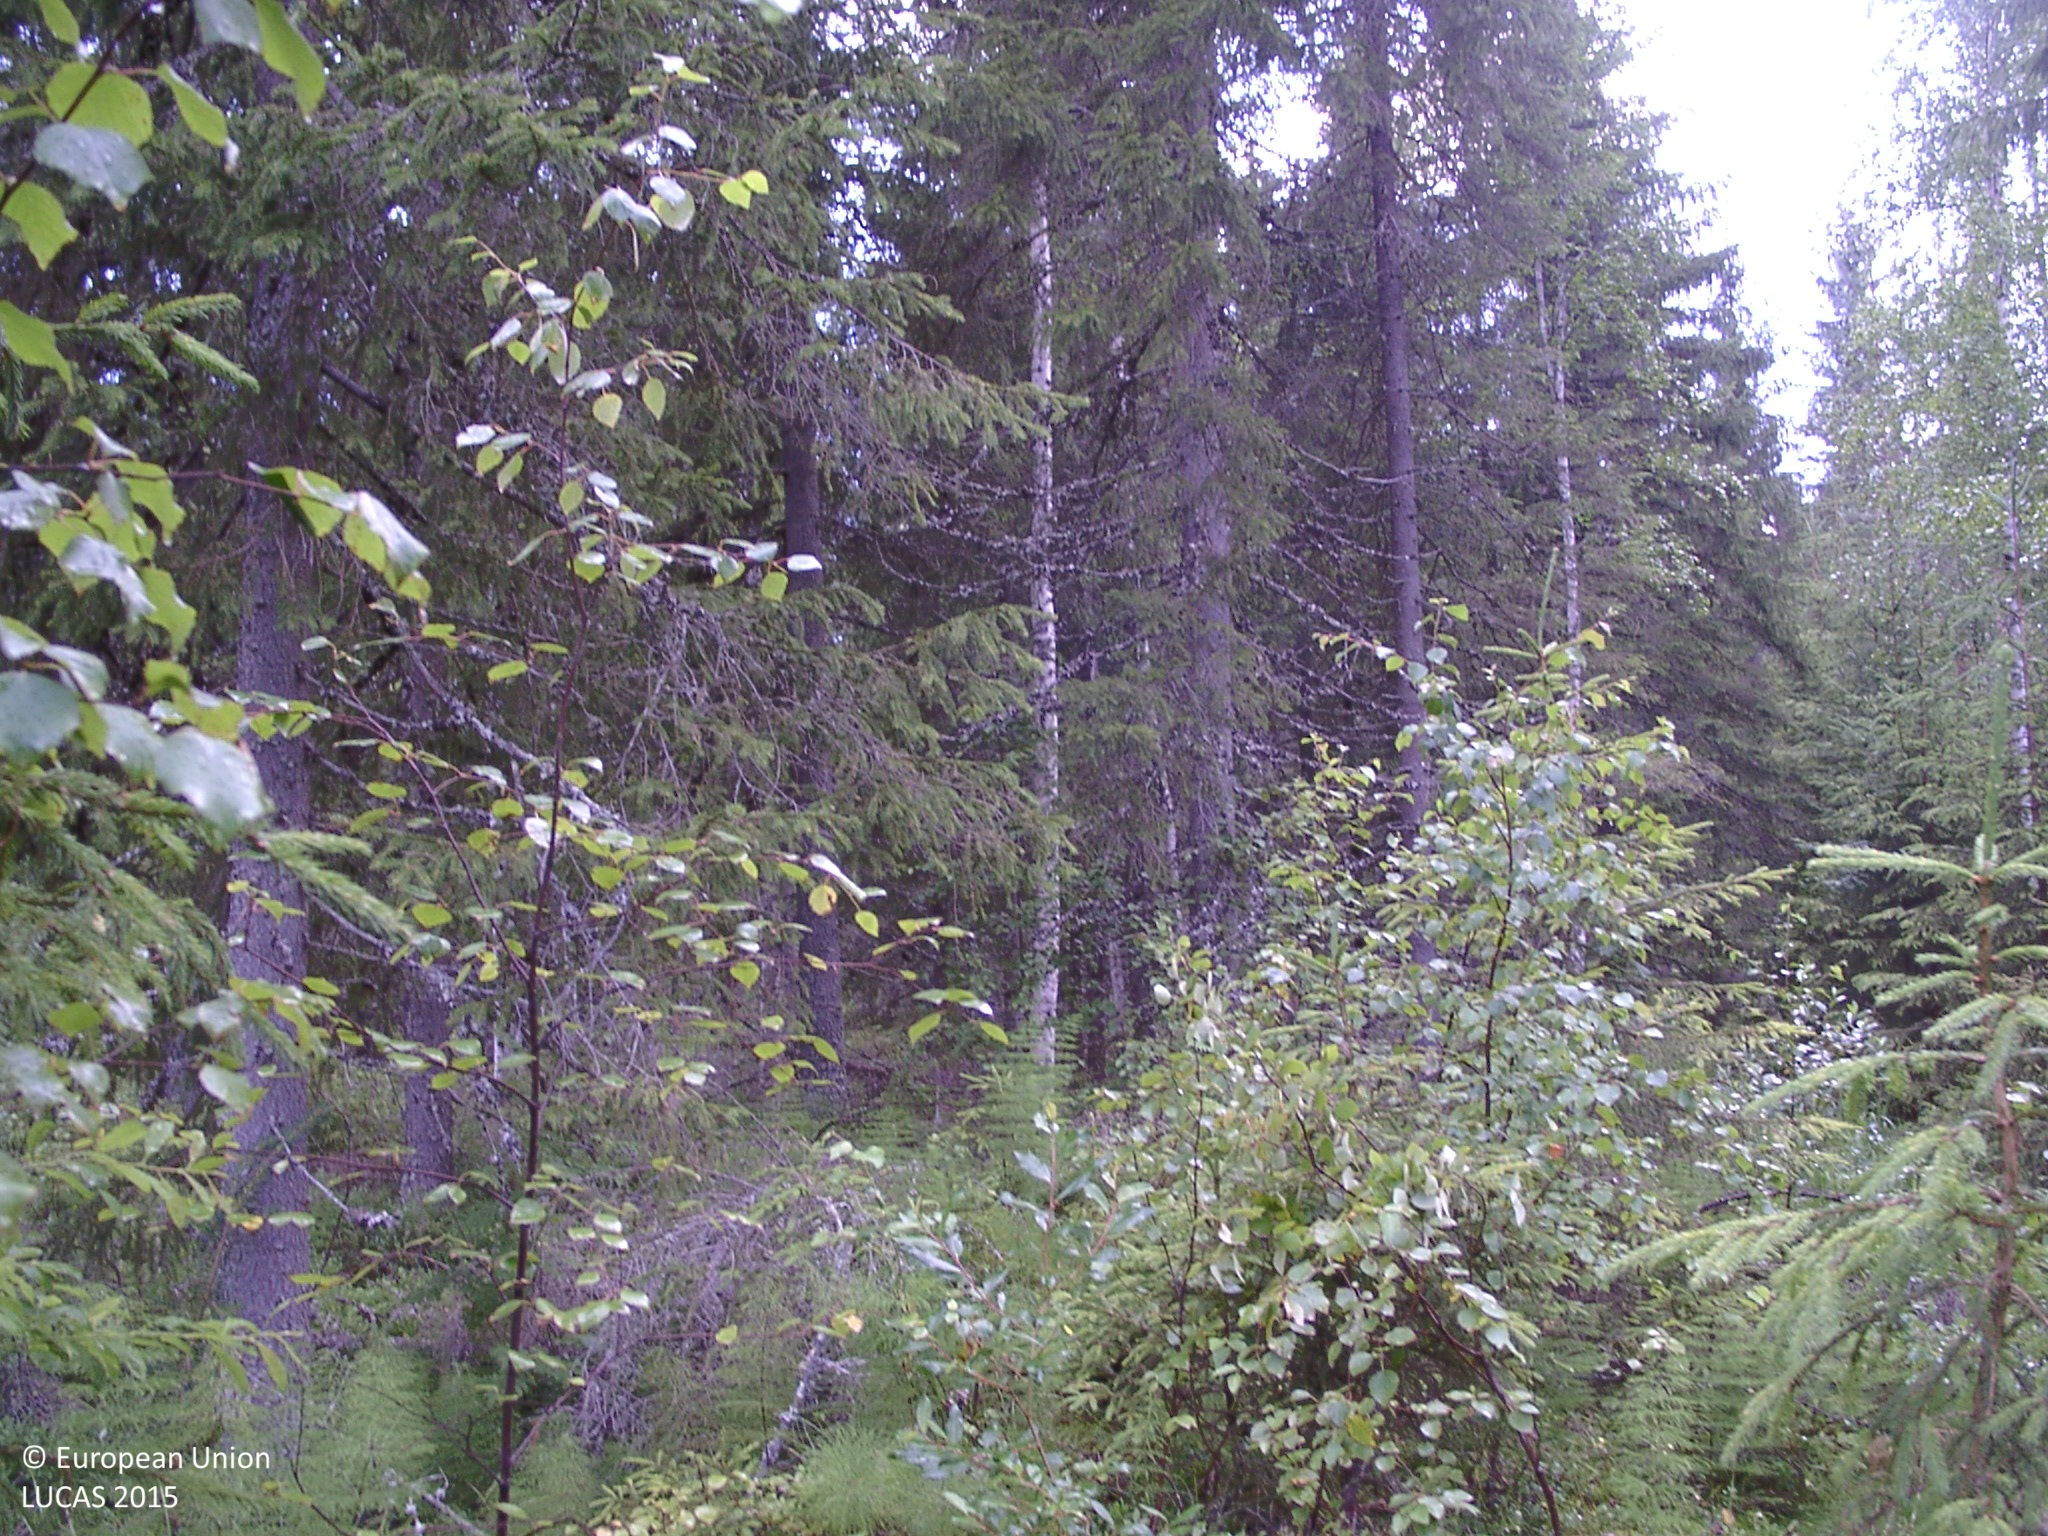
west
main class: Woodland
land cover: Spruce dominated mixed woodland
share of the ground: 50 - 75 %
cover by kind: coniferous forest trees 40 %, broadleaved forest trees 20 %, shrubs 20 %, herbaceous plants 5 %, lichens and mosses 5 %, unconsolidated bare surface 5 %
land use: Forestry
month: July
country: FI
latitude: 62.3255
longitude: 25.2582
